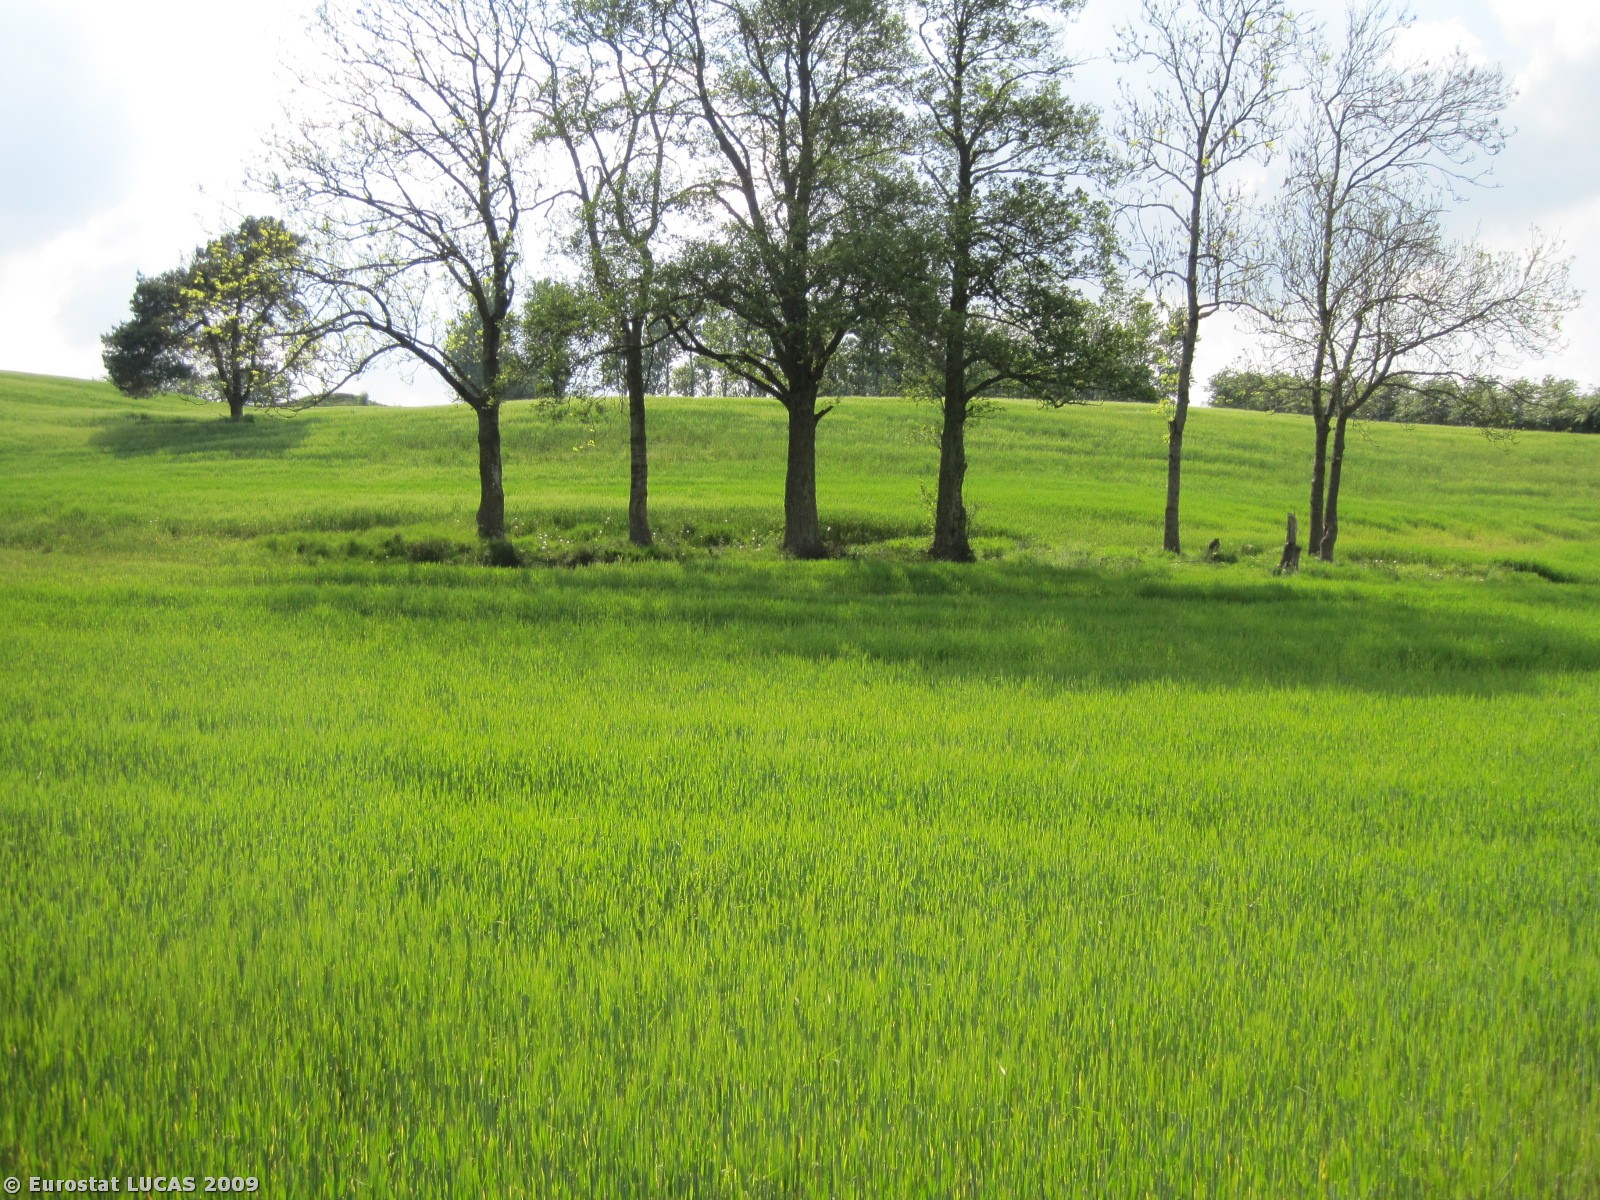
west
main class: Grassland
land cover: Grassland without tree/shrub cover
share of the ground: > 75 %
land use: Unused
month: May
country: DK
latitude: 56.6910
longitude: 10.1467
